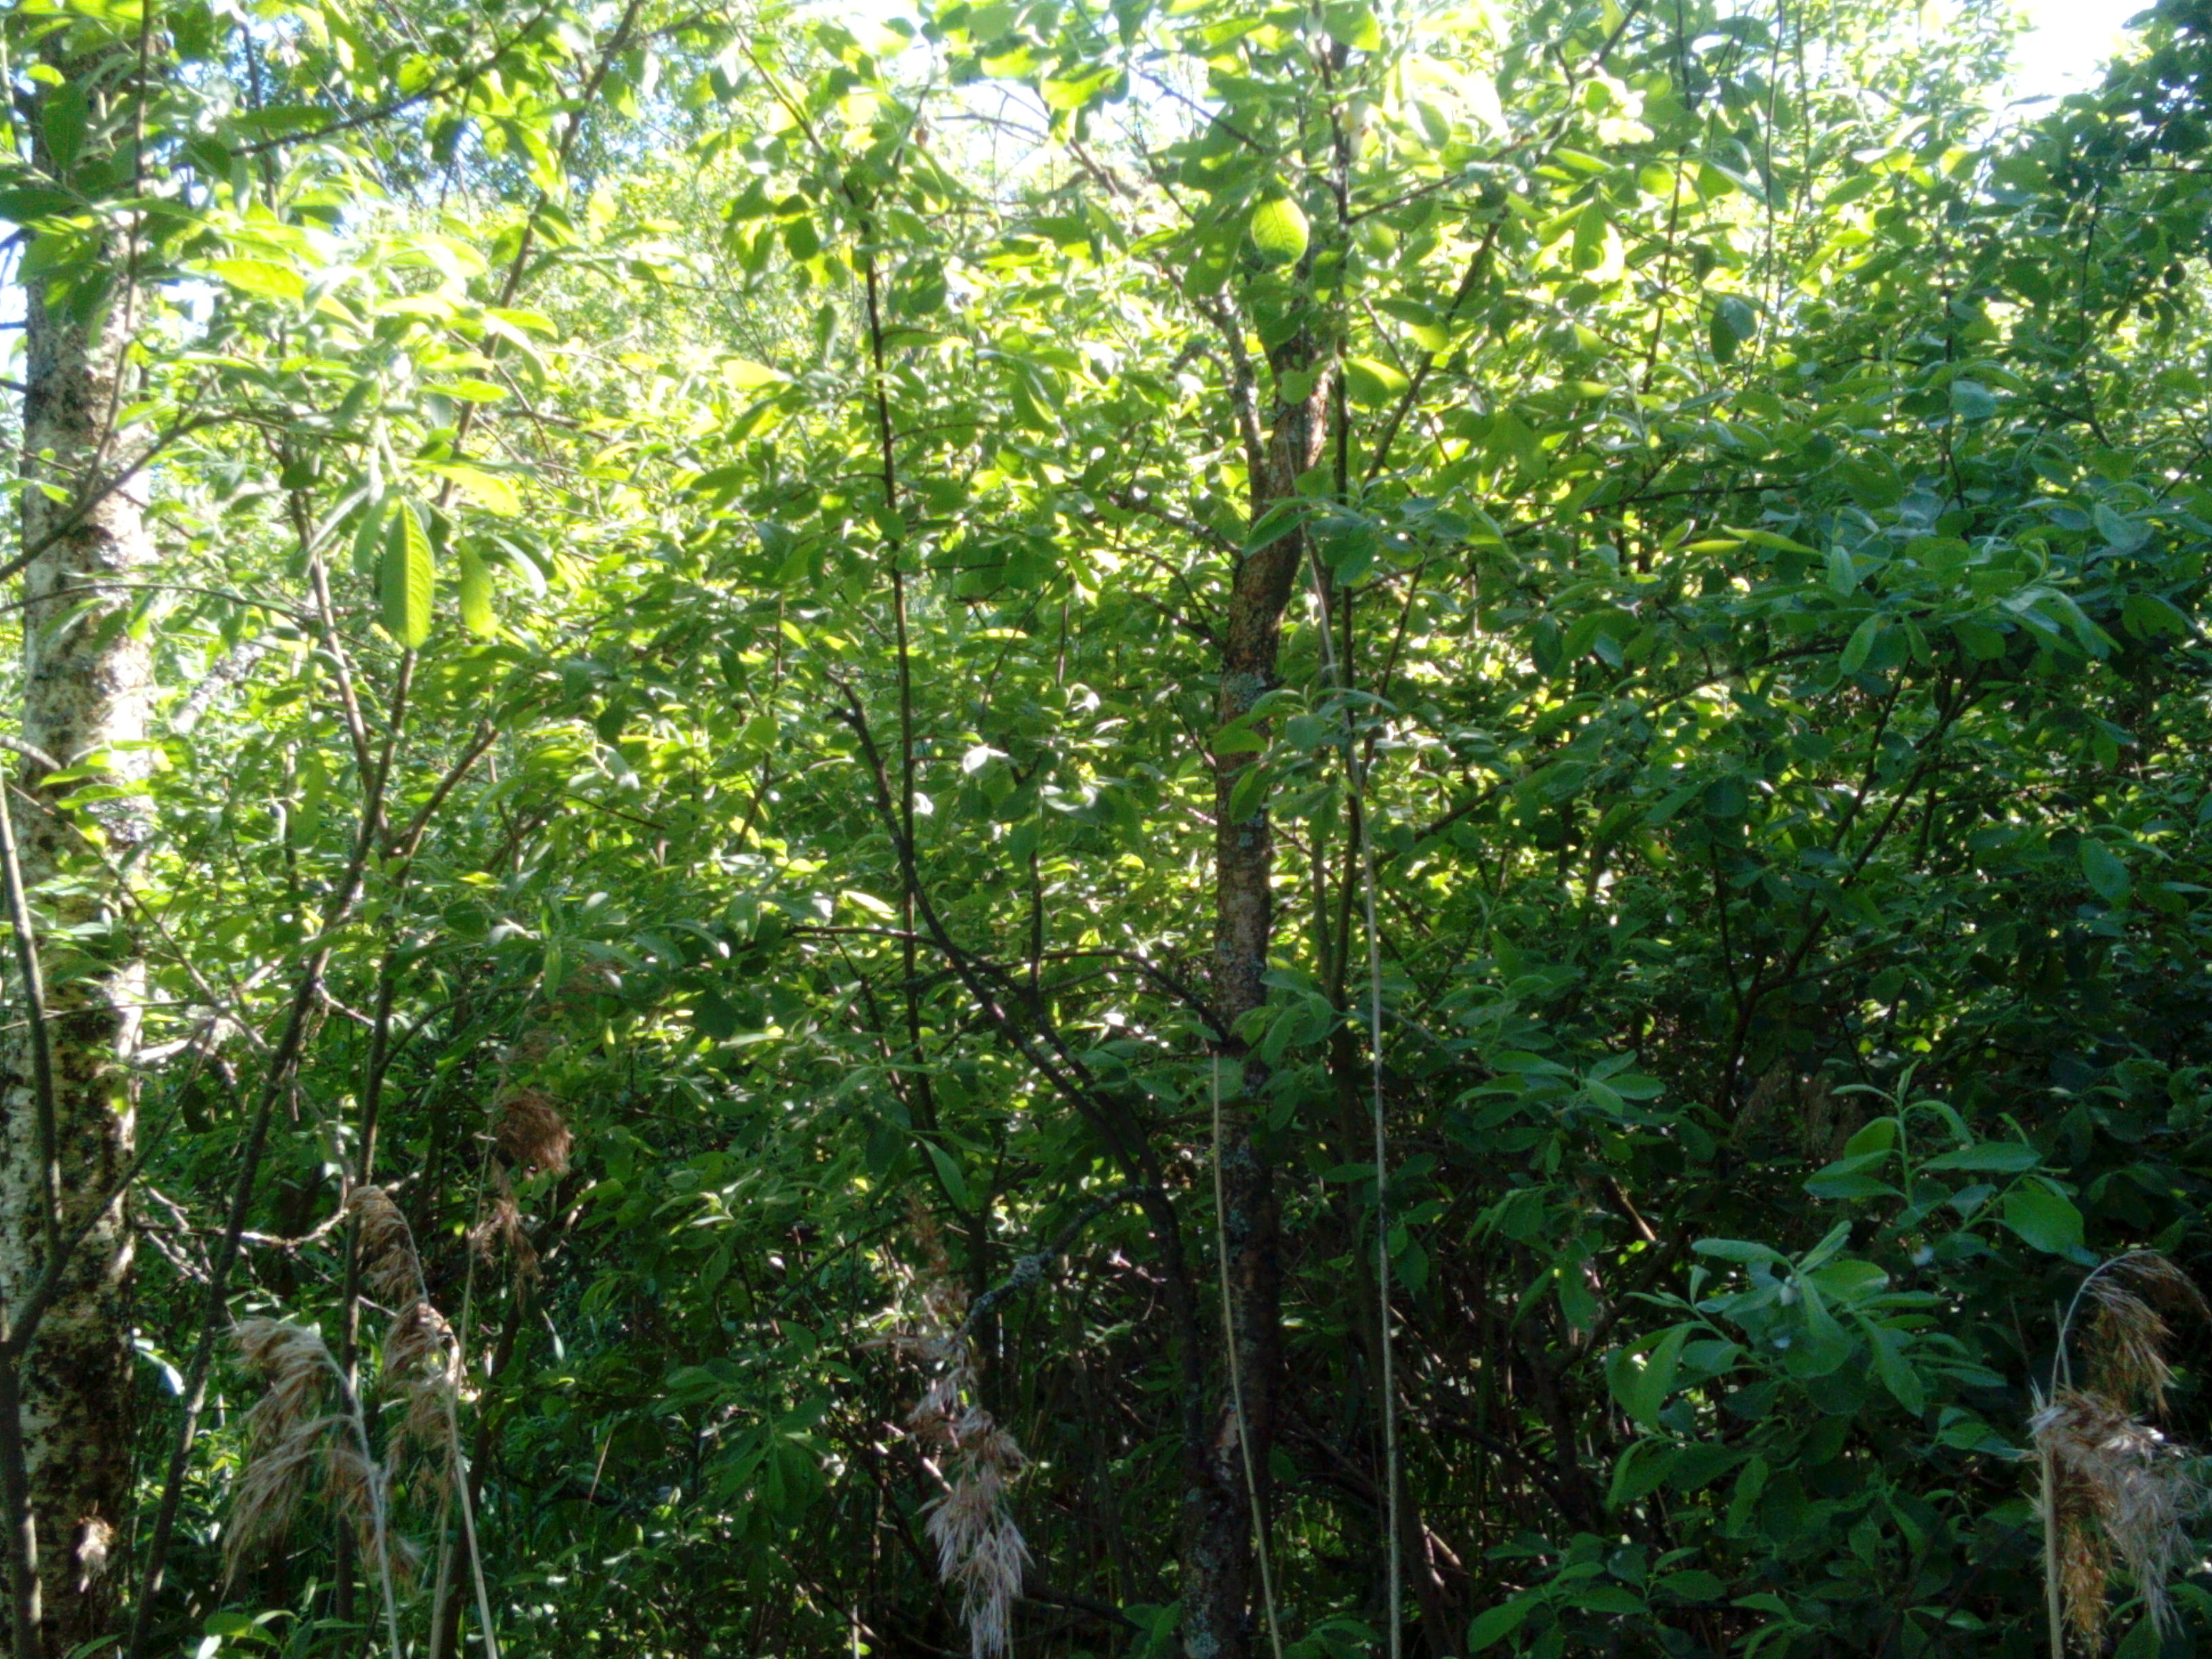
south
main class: Woodland
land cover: Broadleaved woodland
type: non-riverine alder, birch or aspen forest
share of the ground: > 75 %
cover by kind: broadleaved forest trees 65 %, coniferous forest trees 20 %, shrubs 10 %, herbaceous plants 5 %
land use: Forestry
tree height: > 5 m
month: June
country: LV
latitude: 56.5849
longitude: 22.2148
